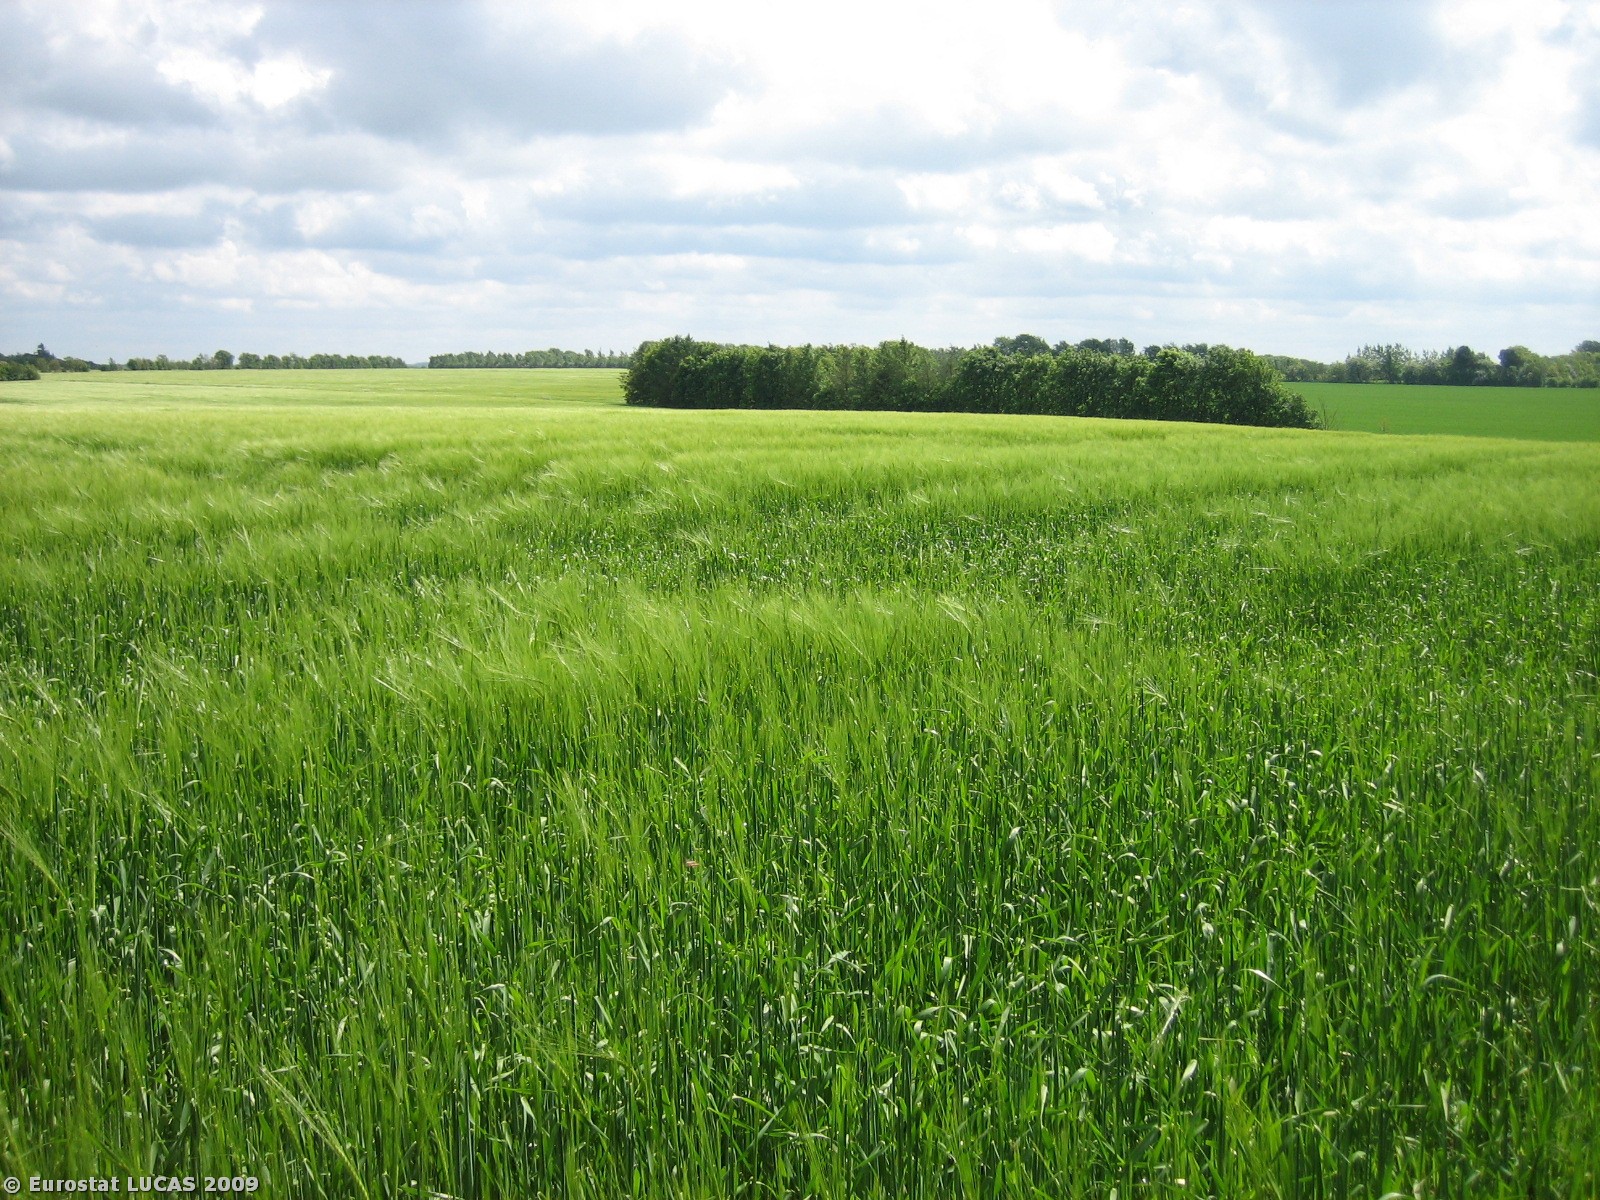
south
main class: Cropland
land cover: Barley
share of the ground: > 75 %
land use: Agriculture (excluding fallow land and kitchen gardens)
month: May
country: DK
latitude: 55.9661
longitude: 8.7677
